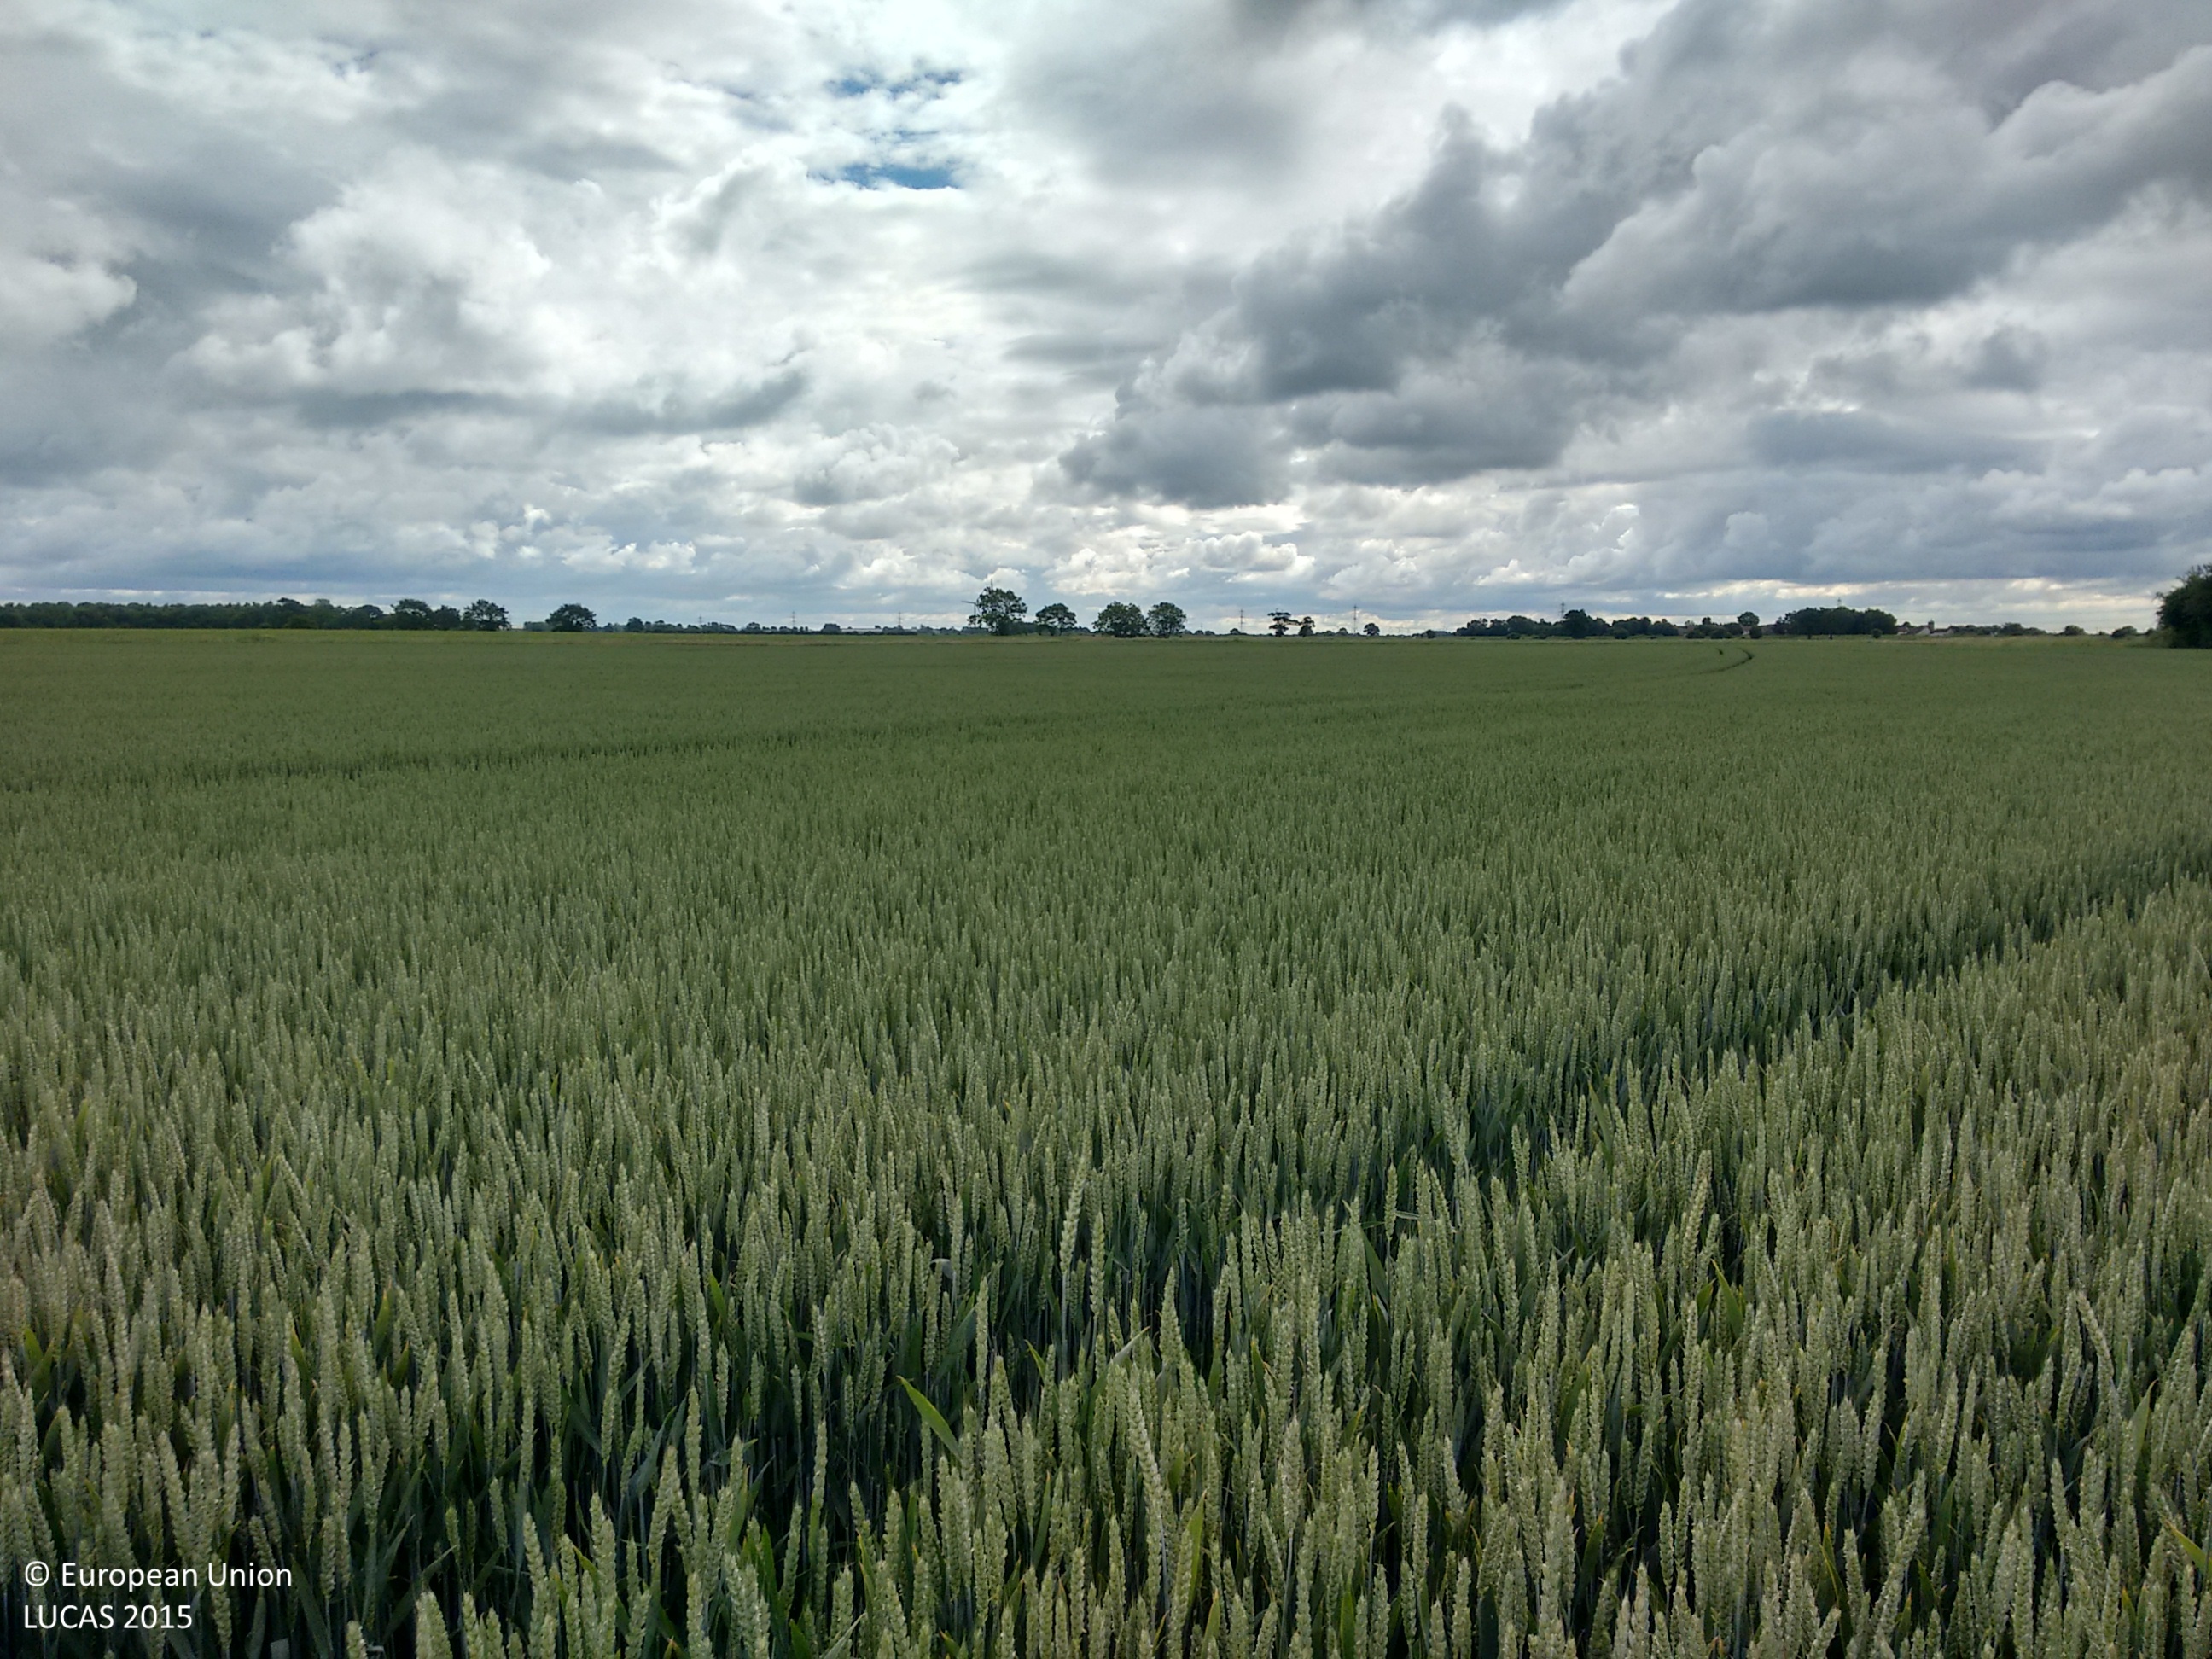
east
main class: Cropland
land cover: Common wheat
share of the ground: > 75 %
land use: Agriculture (excluding fallow land and kitchen gardens)
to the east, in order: Common wheat
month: June
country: GB
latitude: 53.7543
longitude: -0.9777
